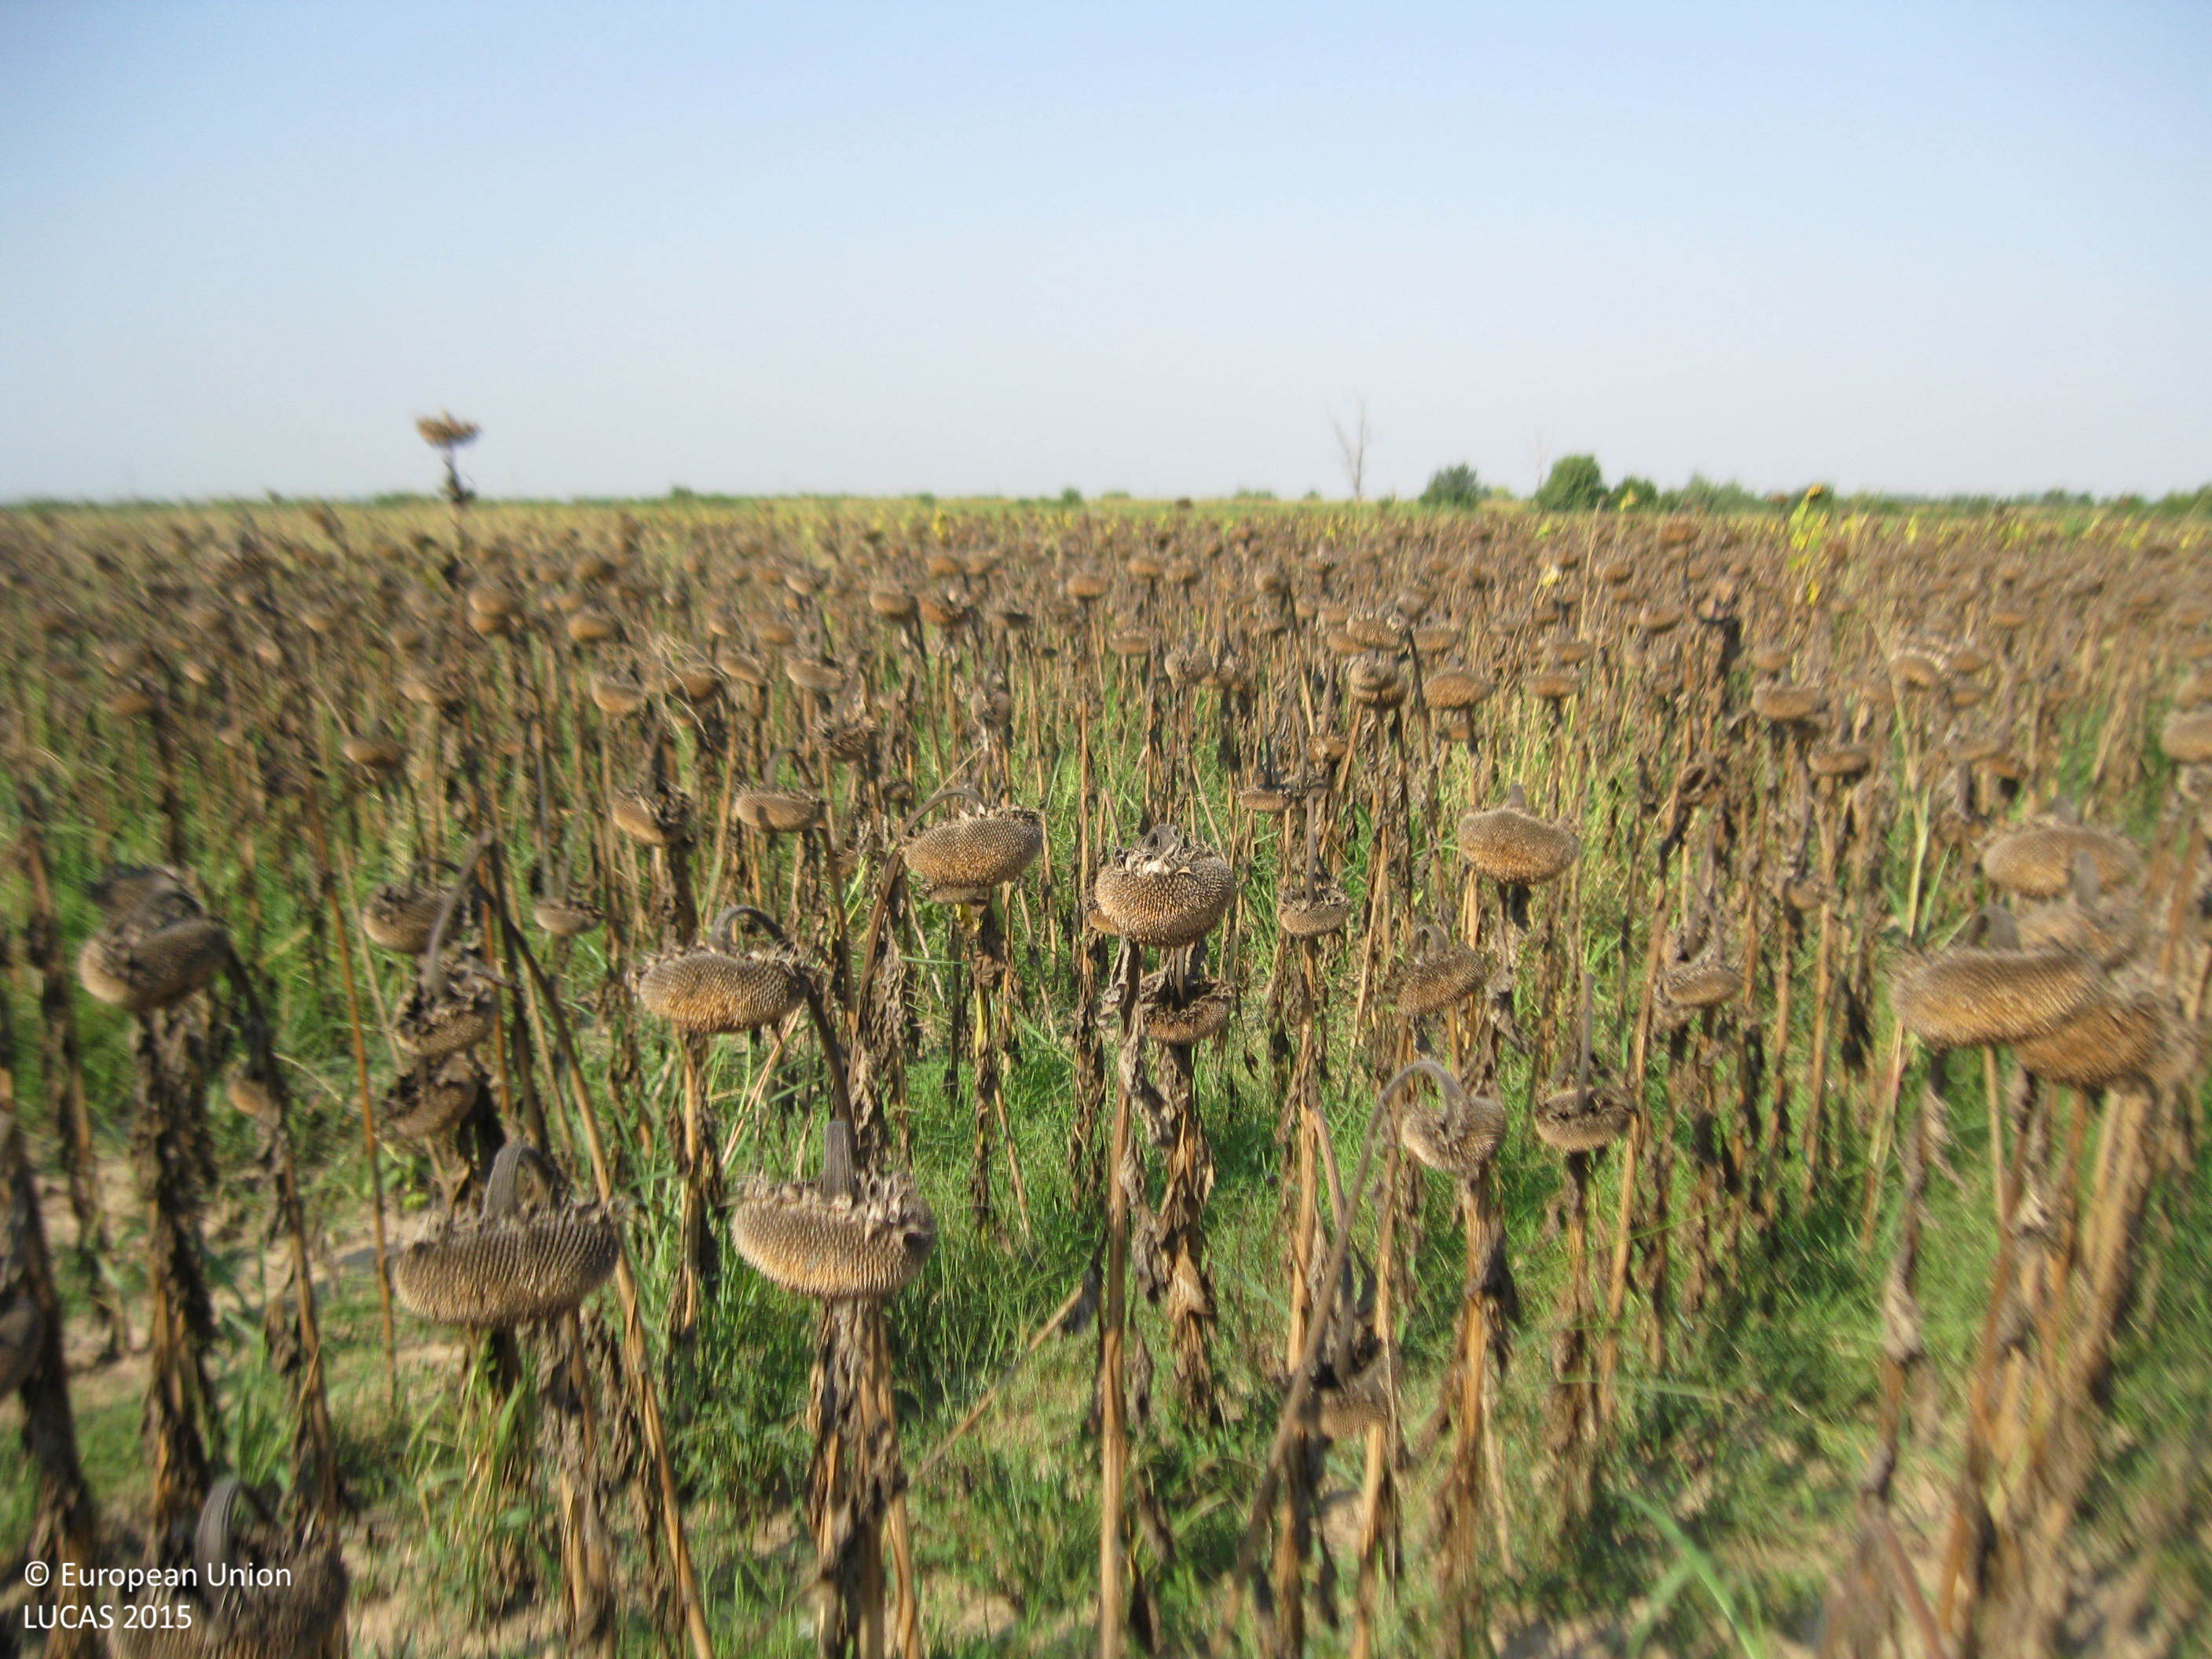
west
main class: Cropland
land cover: Sunflower
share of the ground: > 75 %
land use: Agriculture (excluding fallow land and kitchen gardens)
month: September
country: BG
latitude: 42.2624
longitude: 25.0049
